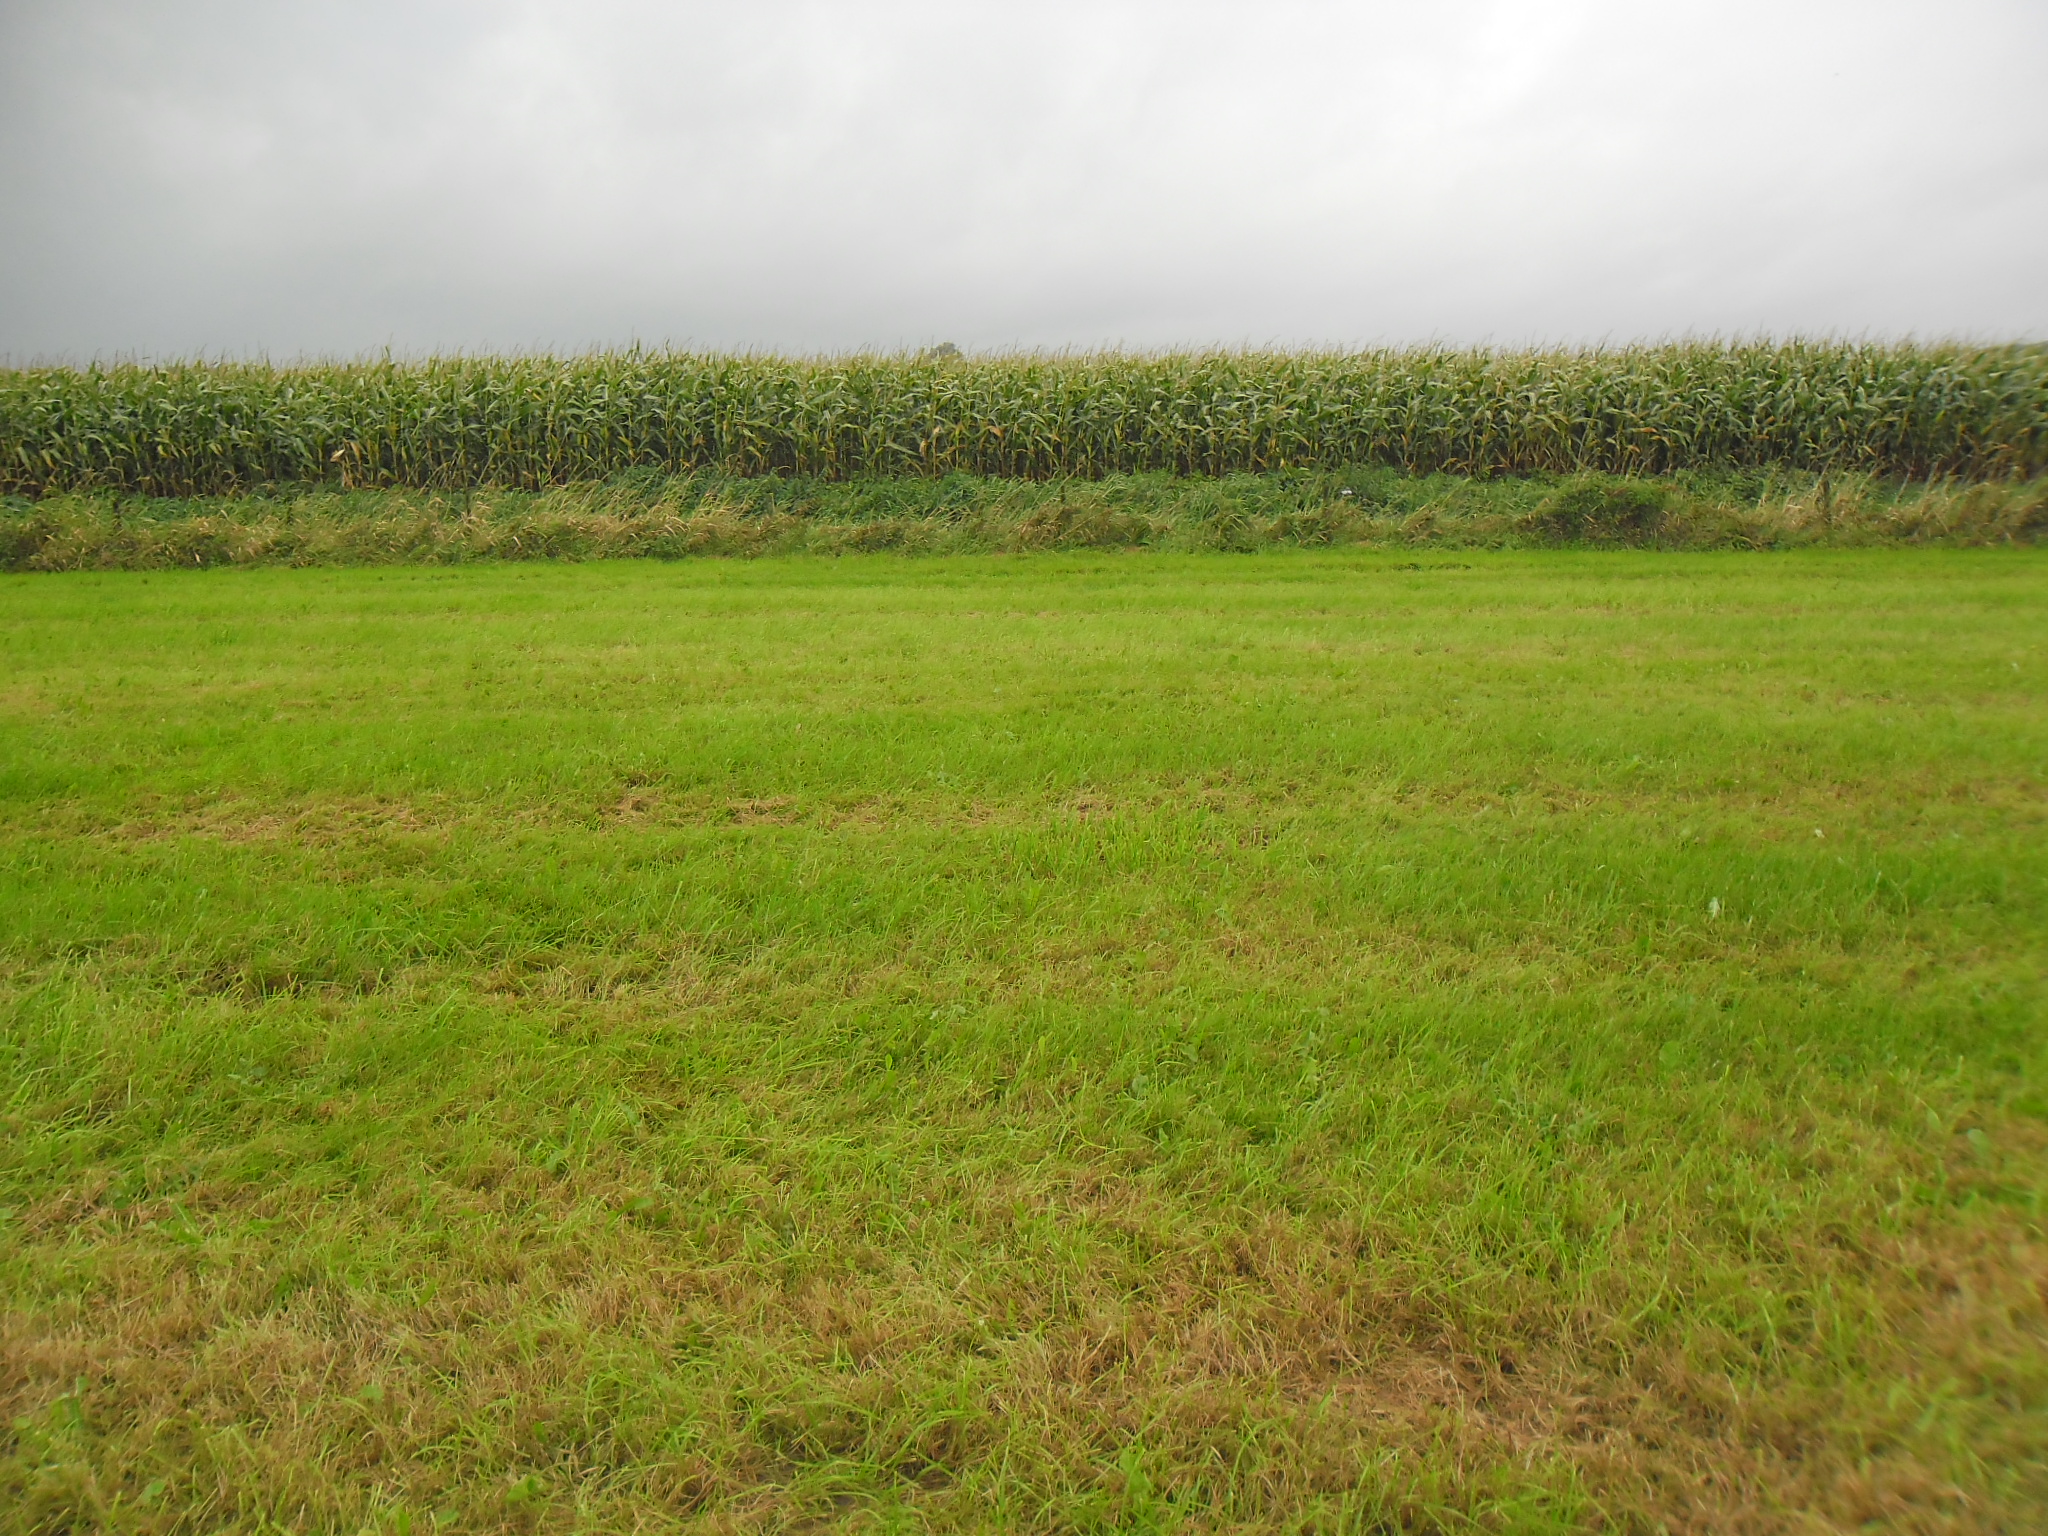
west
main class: Grassland
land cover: Grassland without tree/shrub cover
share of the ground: > 75 %
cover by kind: herbaceous plants 100 %
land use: Agriculture (excluding fallow land and kitchen gardens)
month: September
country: NL
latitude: 51.9578
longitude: 5.7058
